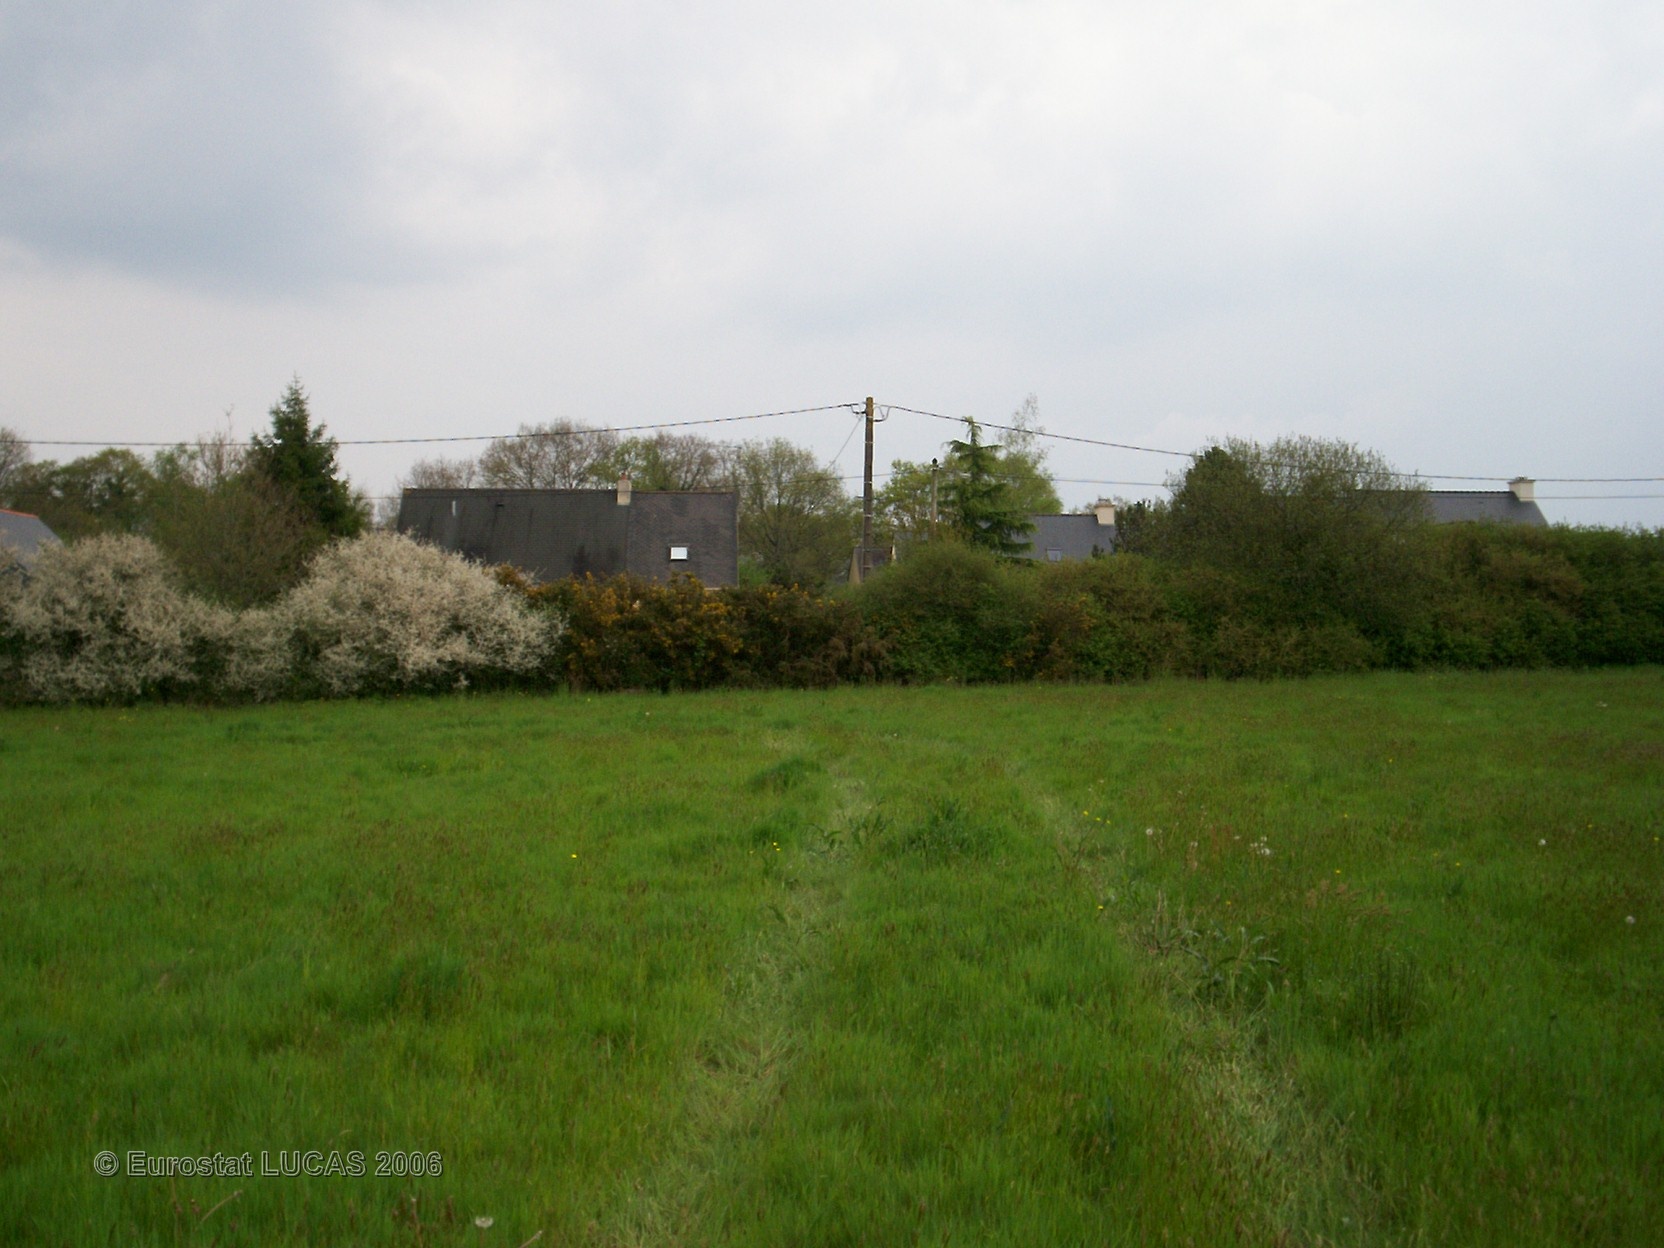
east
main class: Grassland
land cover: Grassland without tree/shrub cover
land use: Agriculture (excluding fallow land and kitchen gardens)
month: April
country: FR
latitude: 47.5823
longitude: -2.6511
